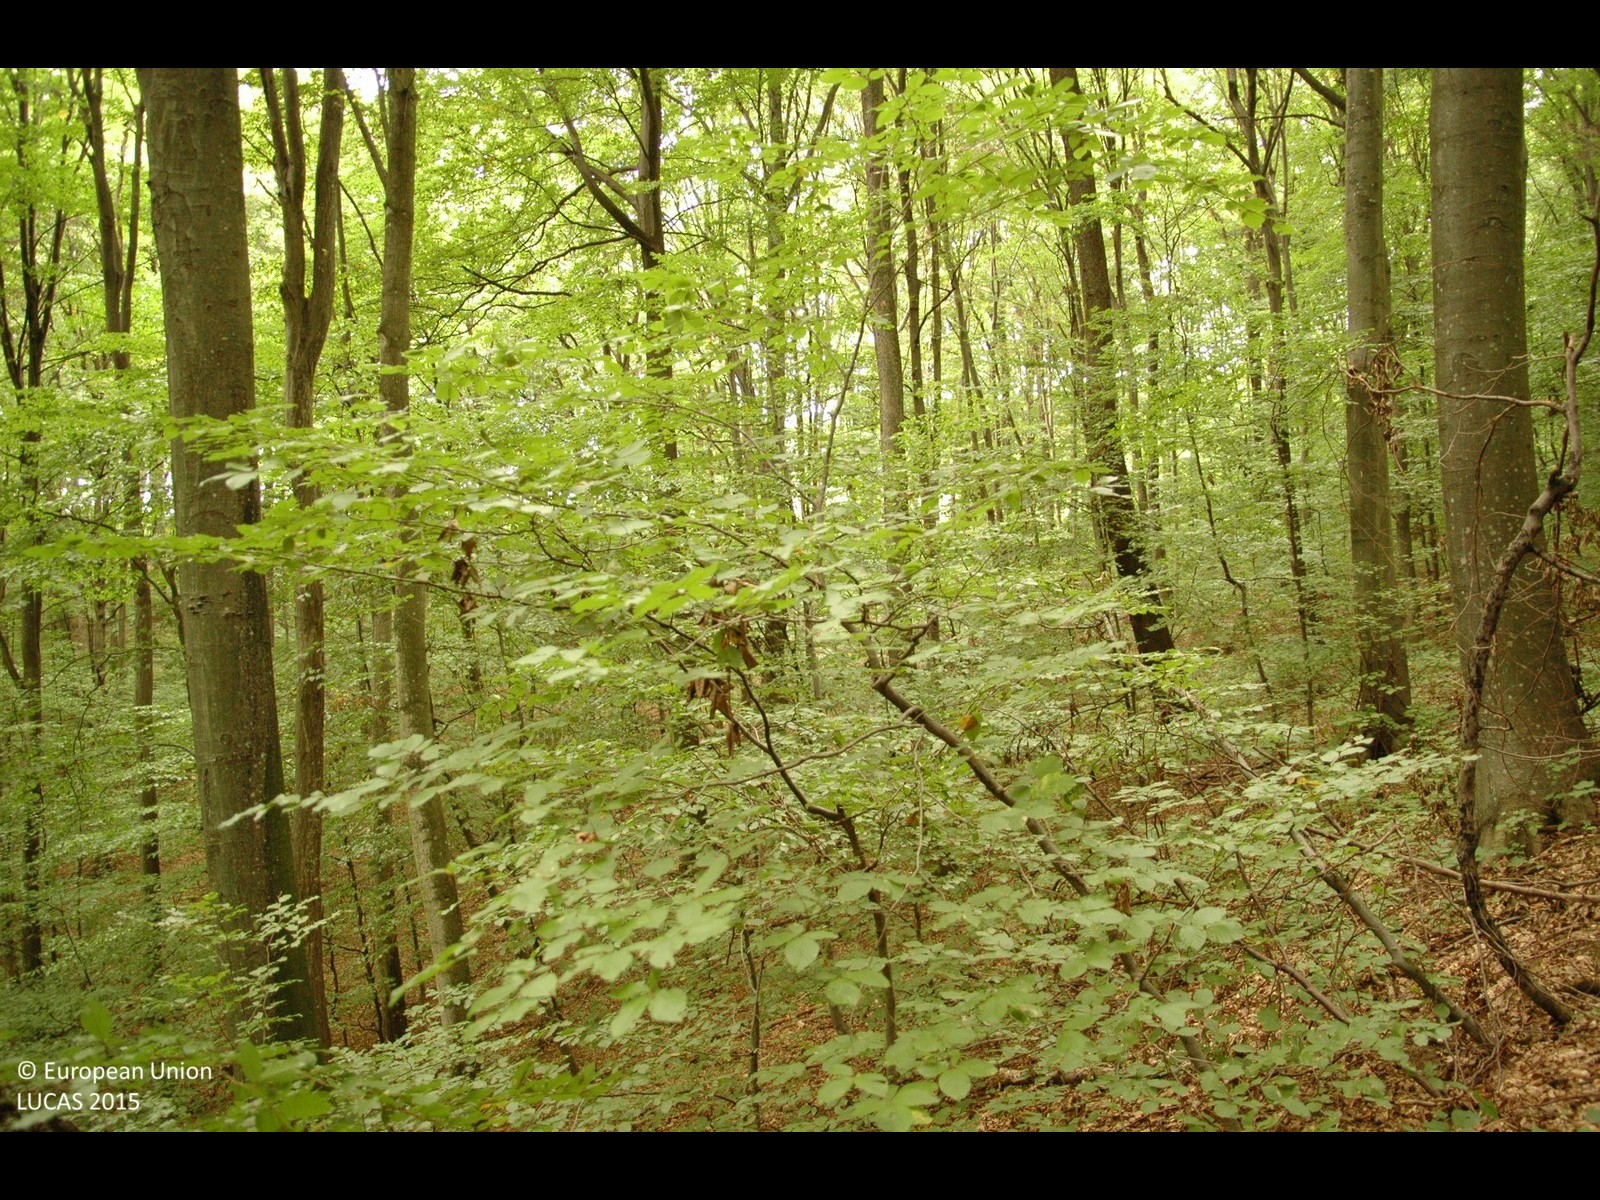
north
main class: Woodland
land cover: Broadleaved woodland
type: beech forest
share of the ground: > 75 %
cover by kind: broadleaved forest trees 100 %
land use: Forestry
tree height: > 5 m
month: September
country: HR
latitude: 46.0877
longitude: 16.6868
